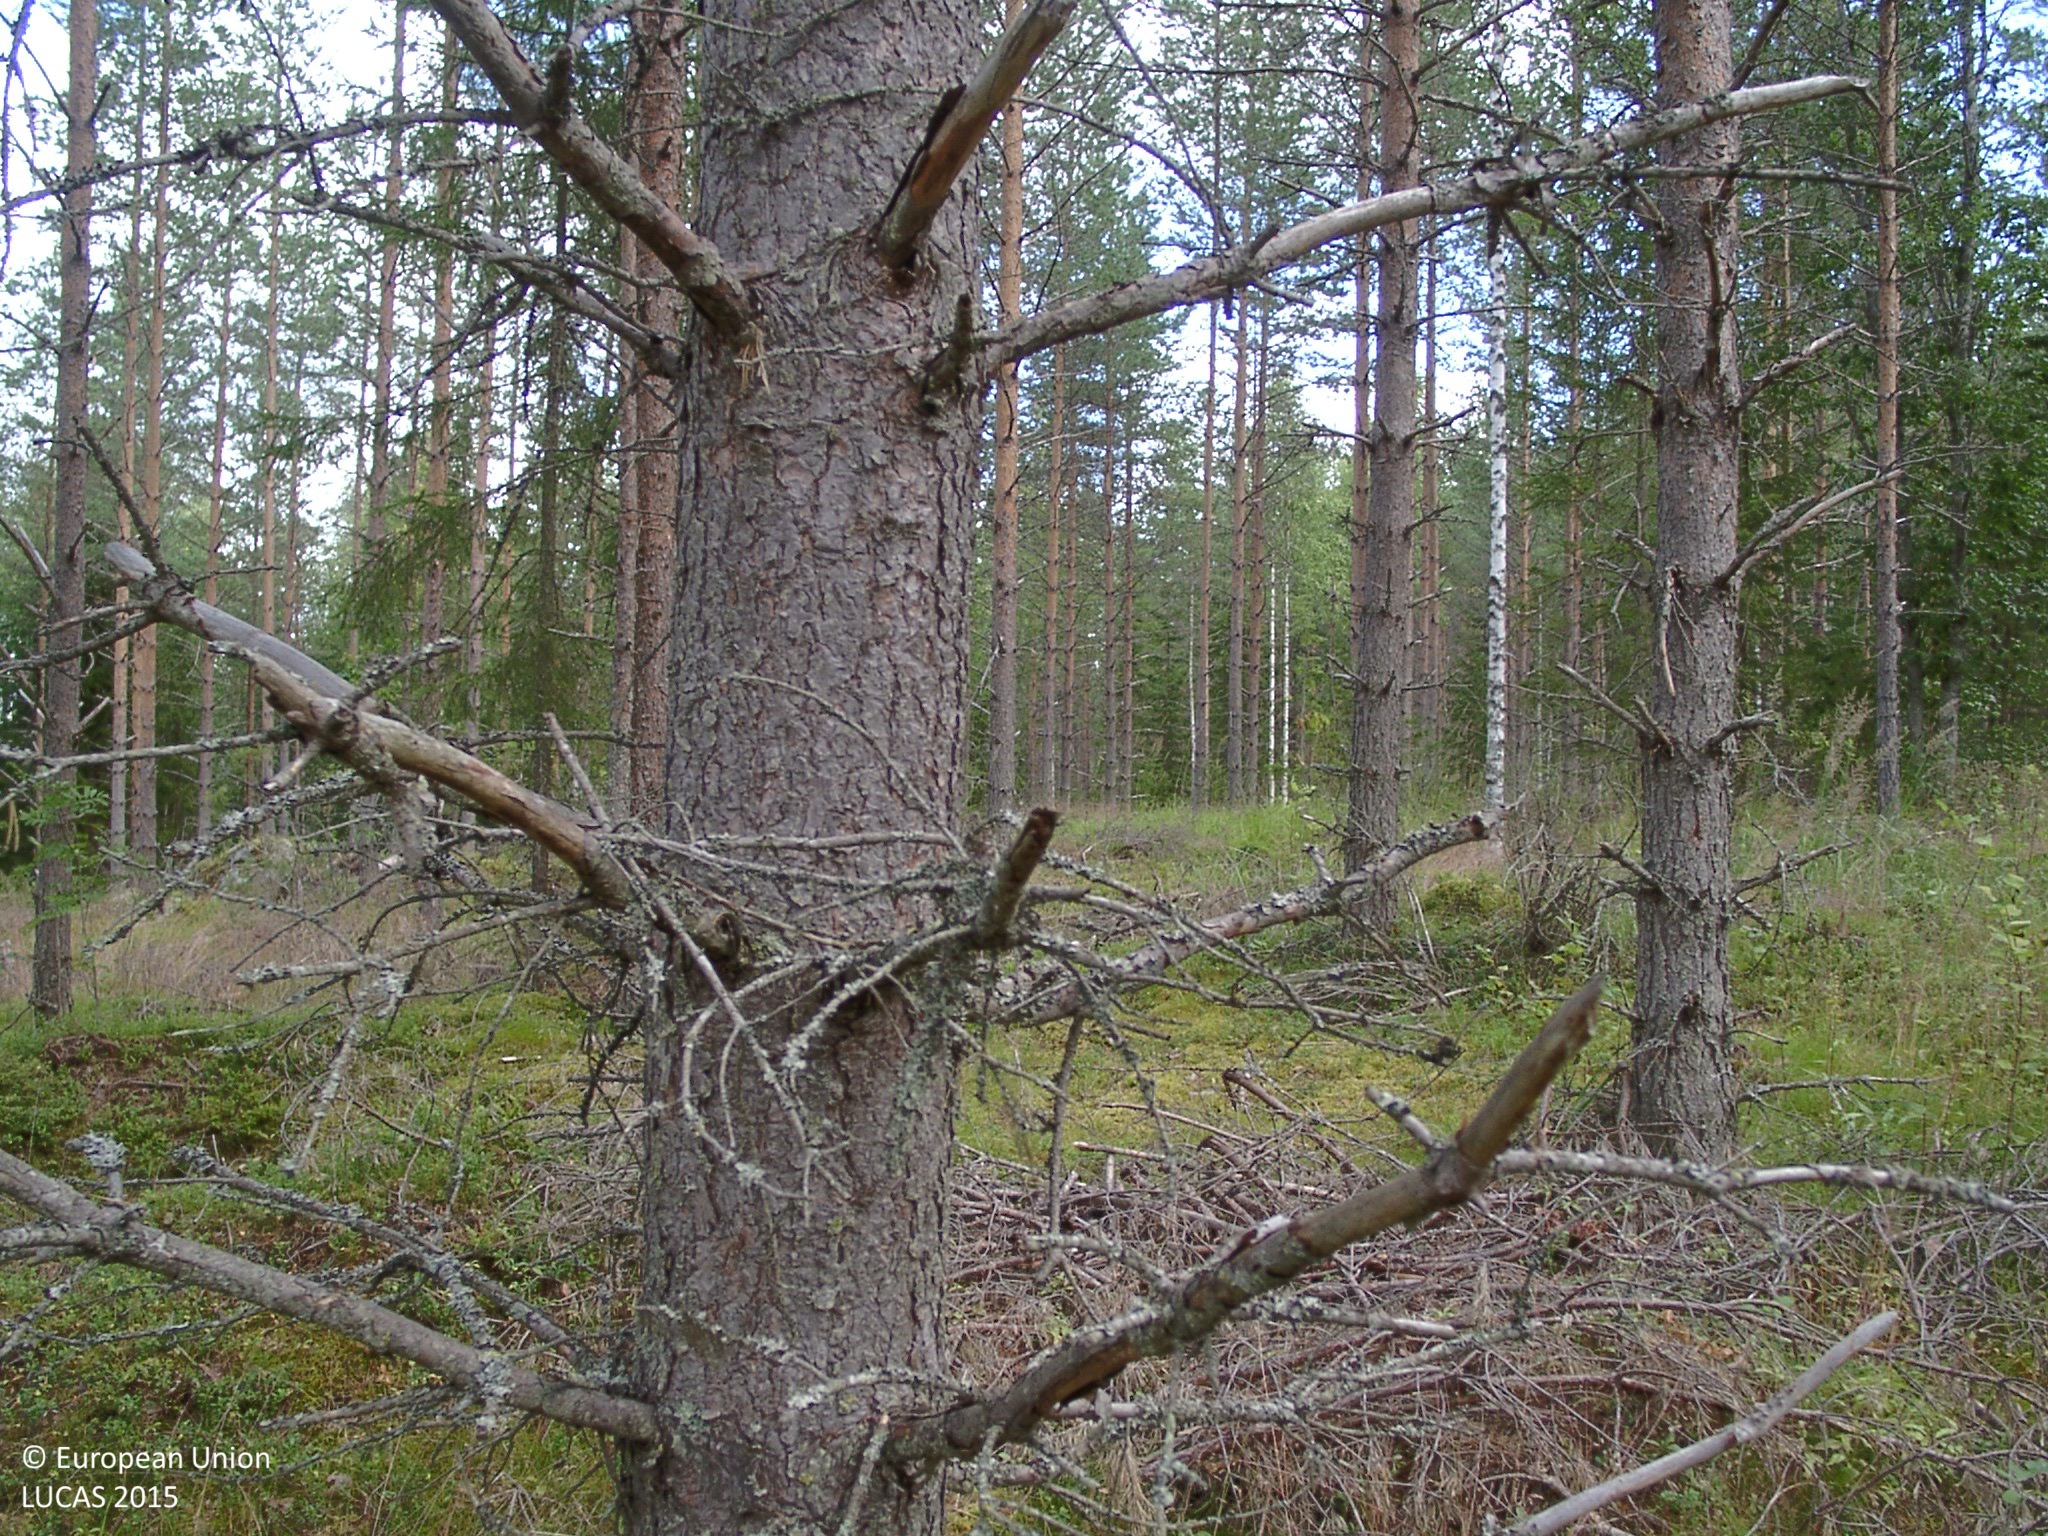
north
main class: Woodland
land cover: Pine dominated coniferous woodland
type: boreal forest
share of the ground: 50 - 75 %
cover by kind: coniferous forest trees 60 %, shrubs 10 %, herbaceous plants 10 %, lichens and mosses 10 %, broadleaved forest trees 5 %
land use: Forestry
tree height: > 5 m
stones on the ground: < 10 %
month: August
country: FI
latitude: 62.3331
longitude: 25.5389
